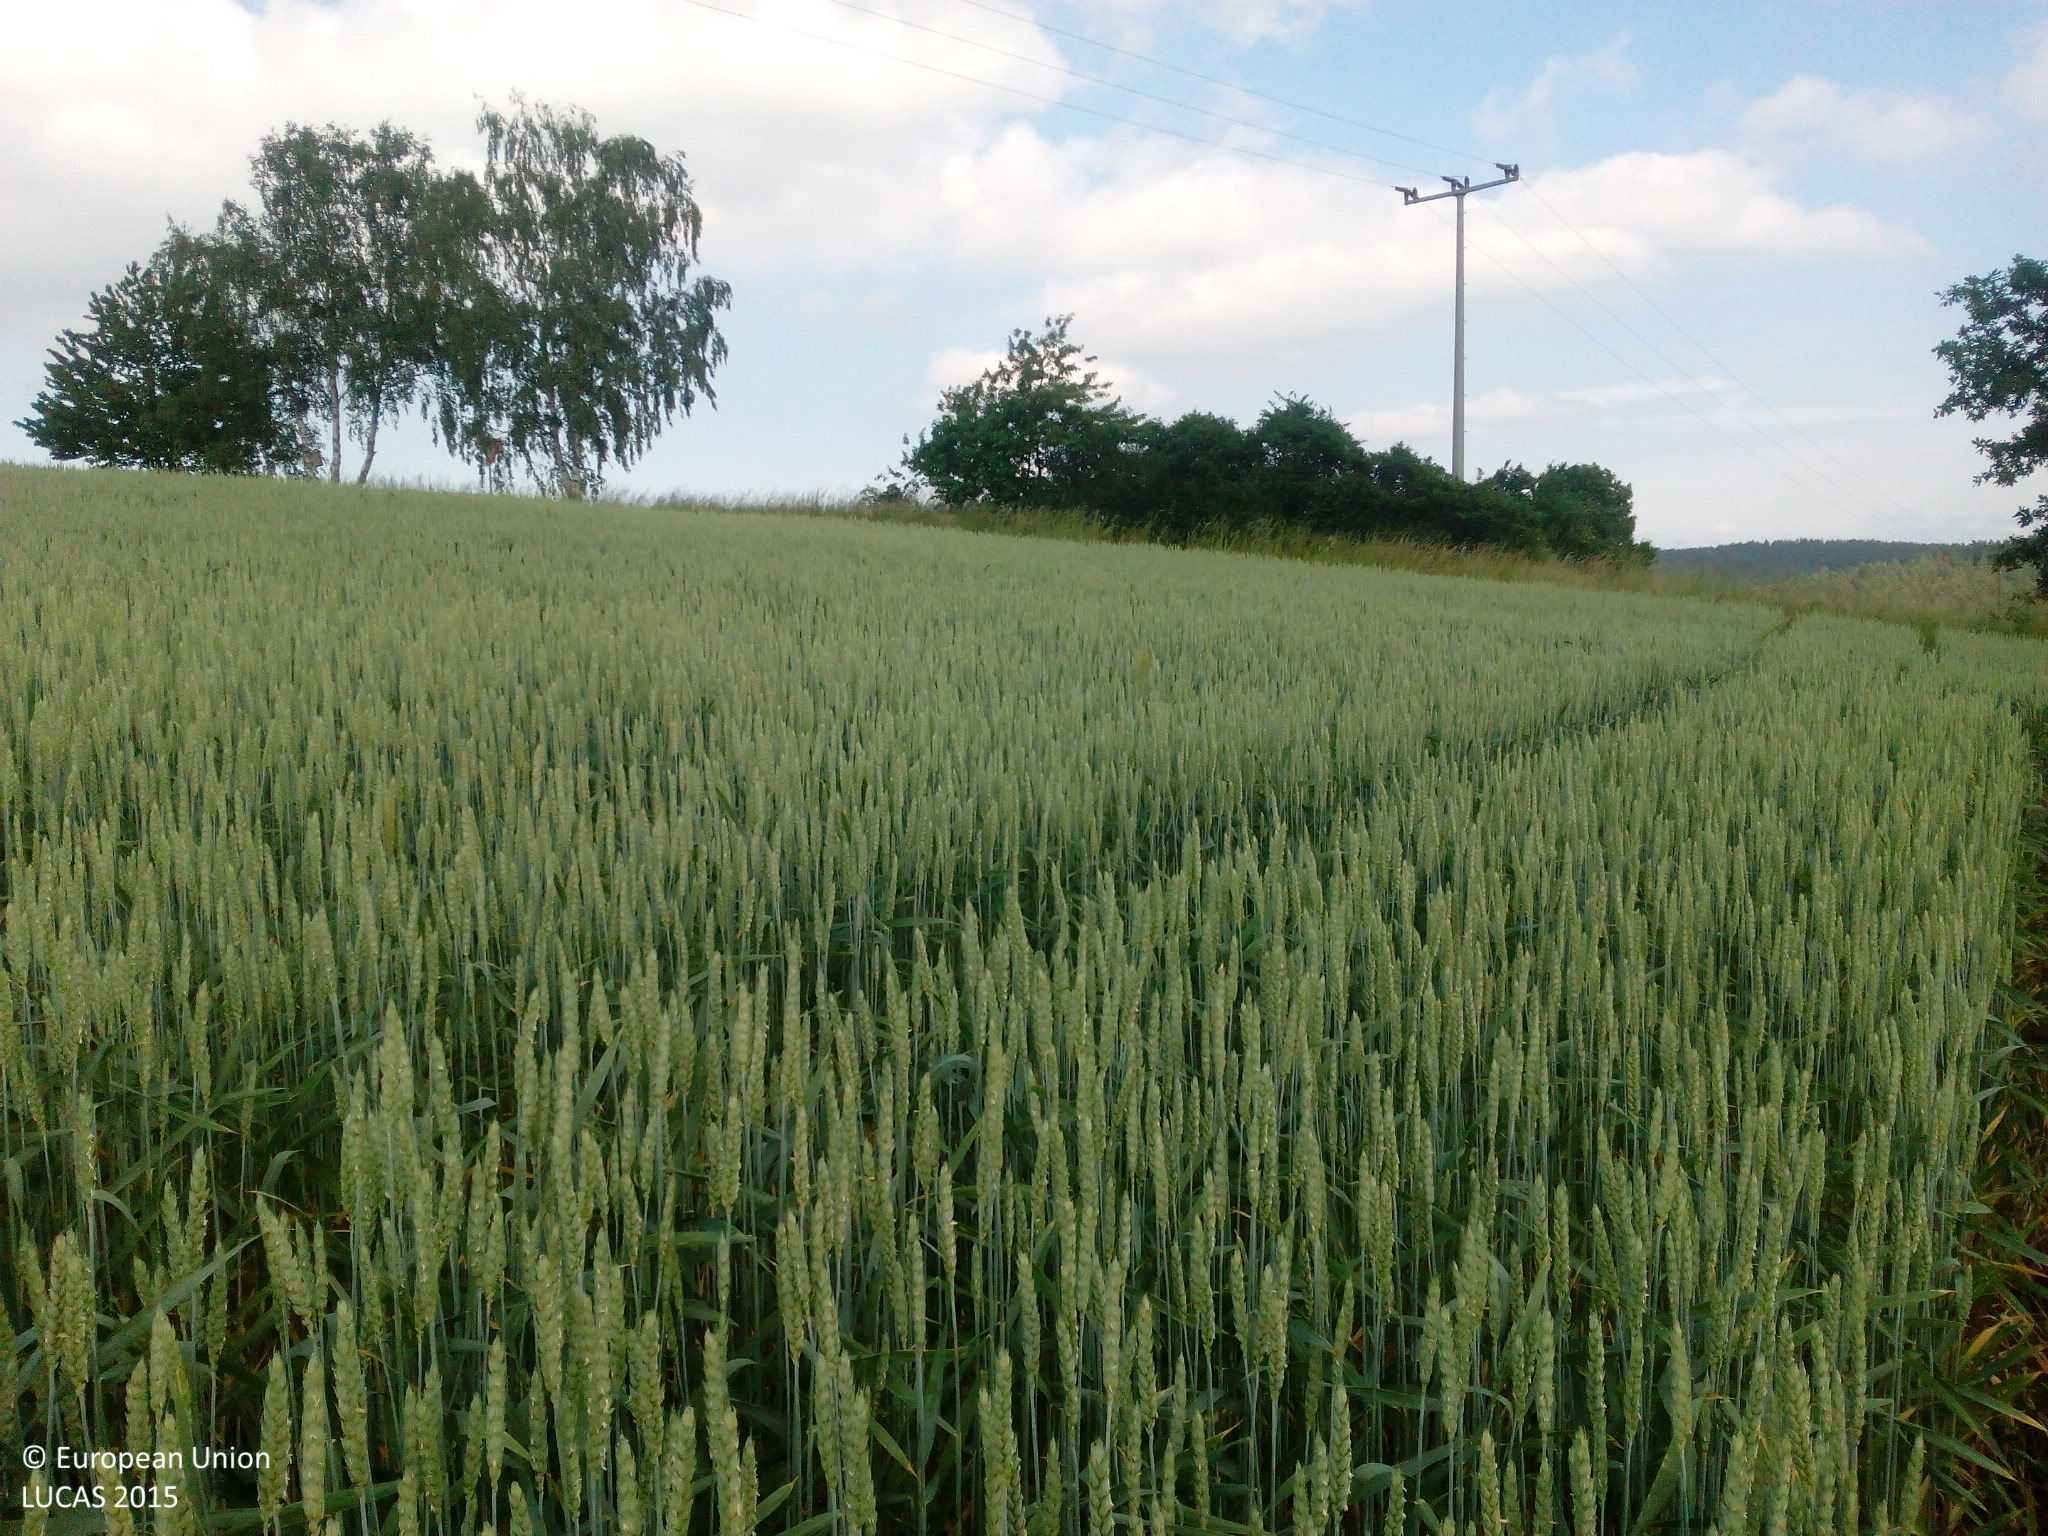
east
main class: Cropland
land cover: Common wheat
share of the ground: > 75 %
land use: Agriculture (excluding fallow land and kitchen gardens)
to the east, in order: Common wheat; Grass margins; Ditches and canals; Grass margins; Paved roads, cycling and walking lanes; Grass margins; Abandoned hedges; Grass margins; Electric lines; Single bushes/trees; Grass margins; Maize; Grass margins; Paved roads, cycling and walking lanes; Grassland without tree/shrub cover
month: June
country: DE
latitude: 49.4975
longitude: 12.1949
